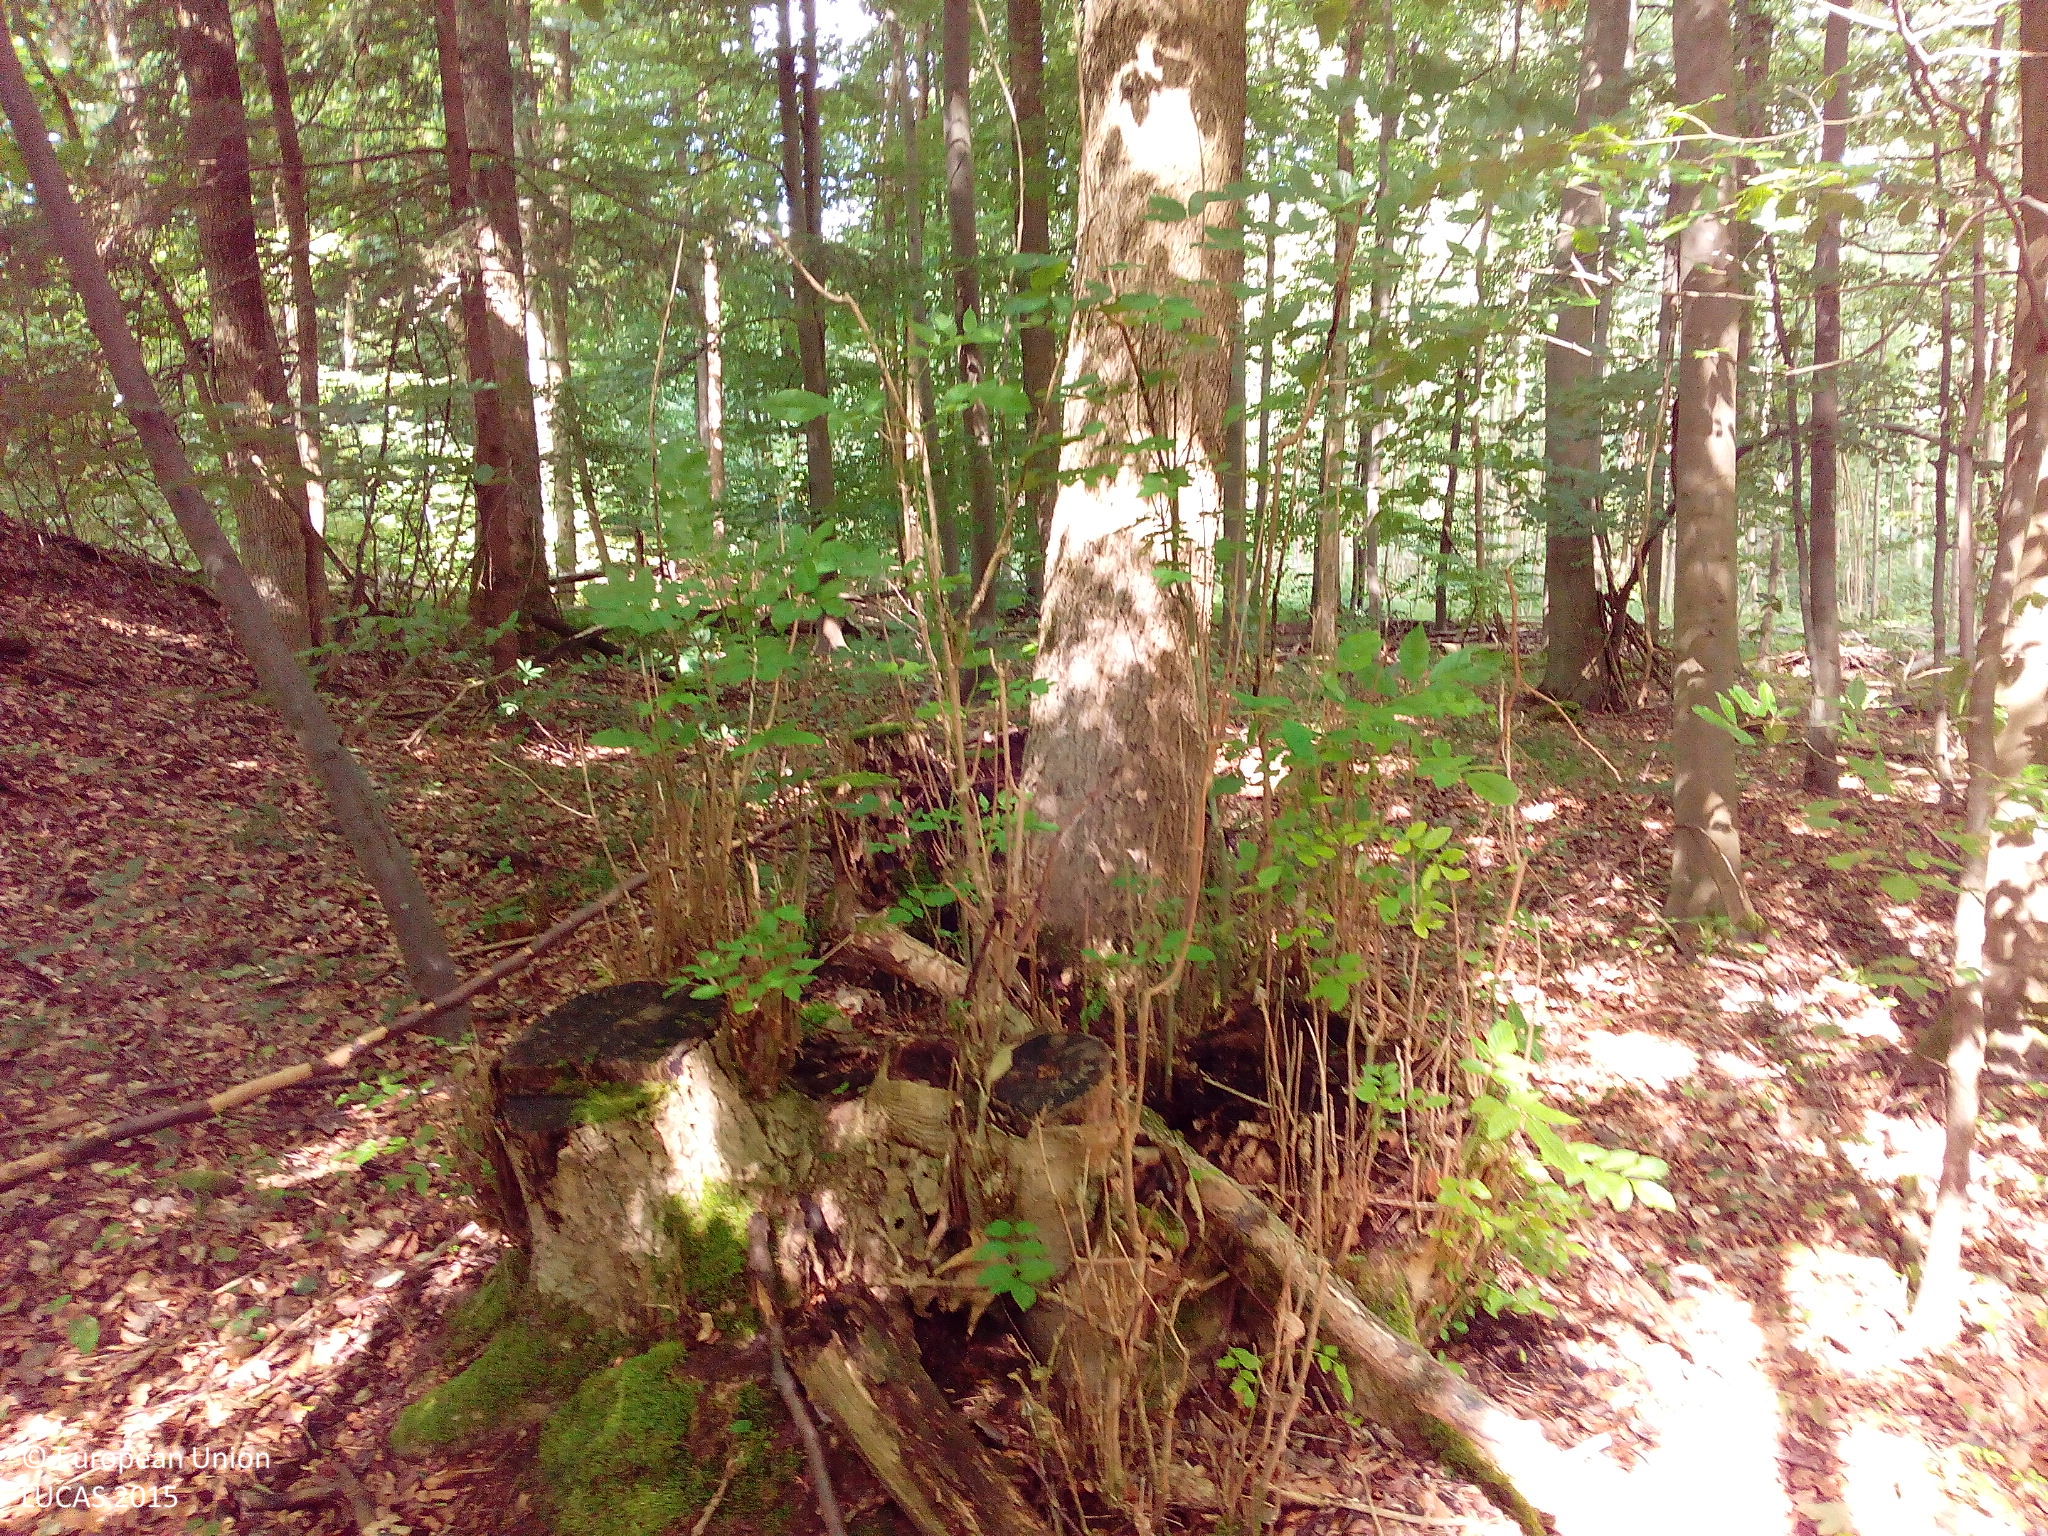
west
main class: Woodland
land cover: Broadleaved woodland
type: beech forest
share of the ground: > 75 %
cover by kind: broadleaved forest trees 100 %
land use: Forestry
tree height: > 5 m
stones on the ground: < 10 %
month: July
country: DE
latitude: 50.9933
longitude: 9.9288
